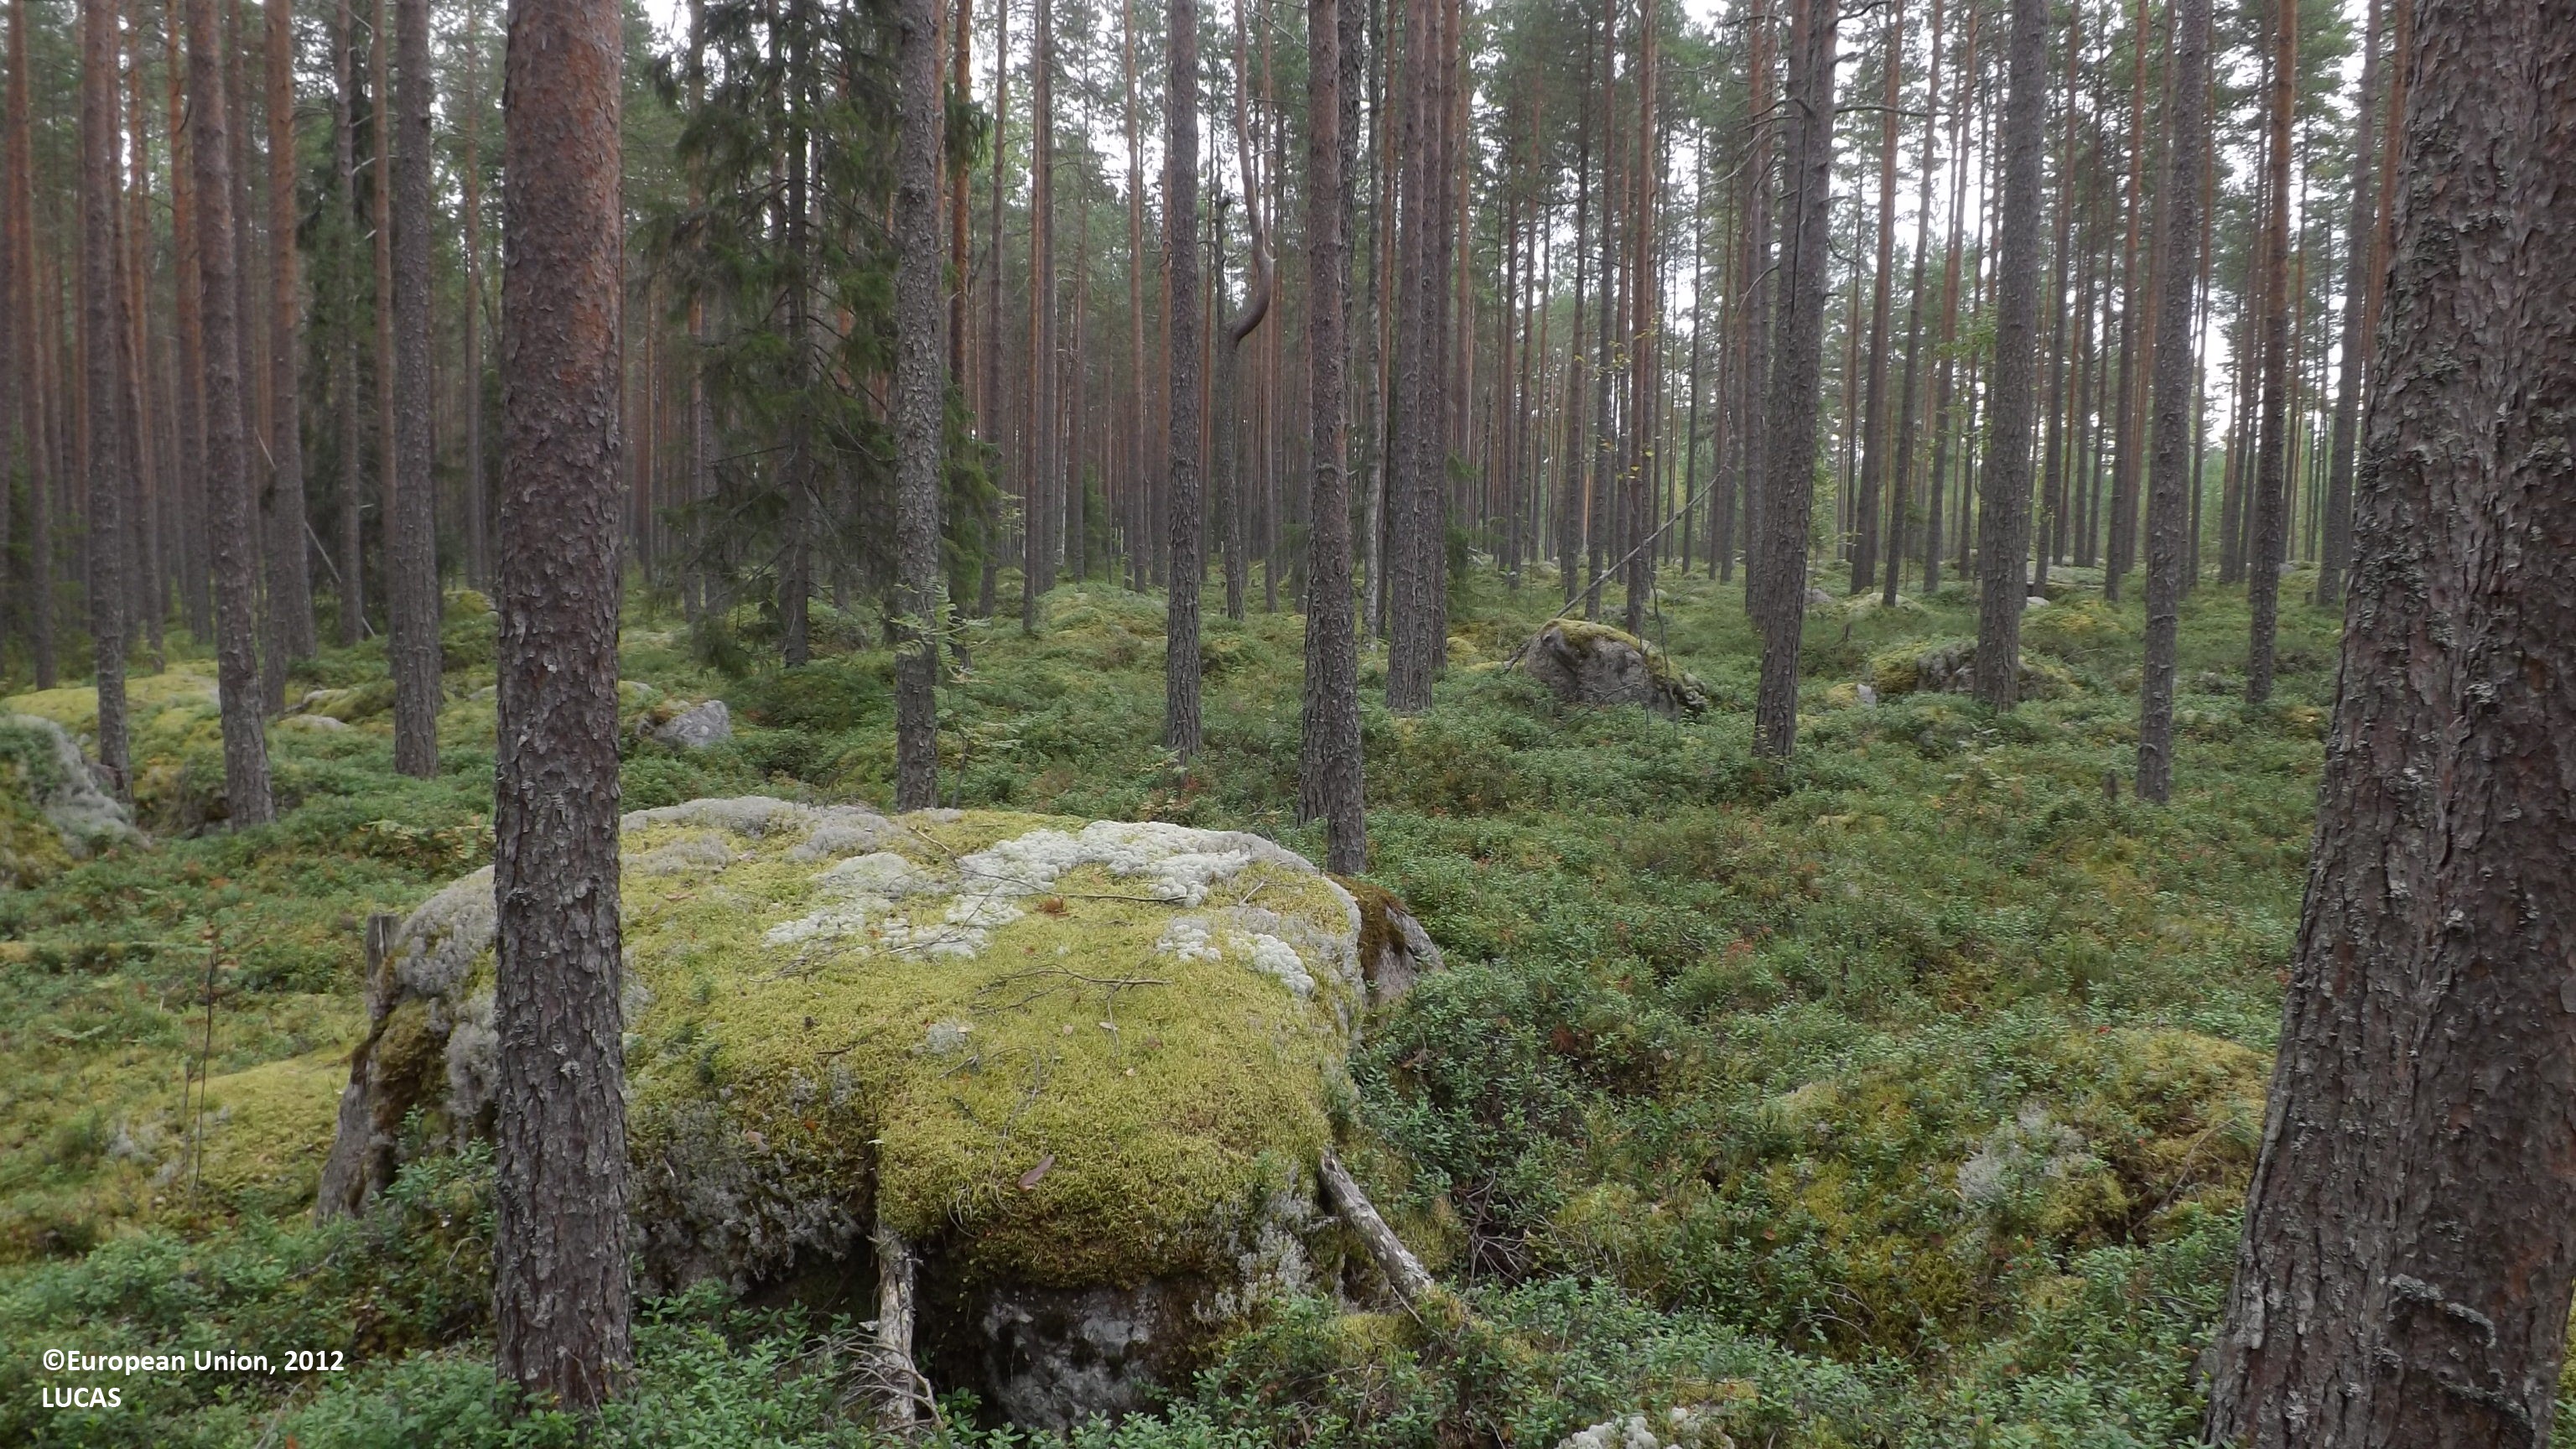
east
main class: Woodland
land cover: Pine dominated coniferous woodland
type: boreal forest
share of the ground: 50 - 75 %
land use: Forestry
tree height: > 5 m
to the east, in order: Pine dominated coniferous woodland; Pine dominated mixed woodland; Ditches and canals; Pine dominated mixed woodland; Tracks; Pine dominated mixed woodland; Pine dominated coniferous woodland
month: August
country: FI
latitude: 63.9672
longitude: 24.0973
